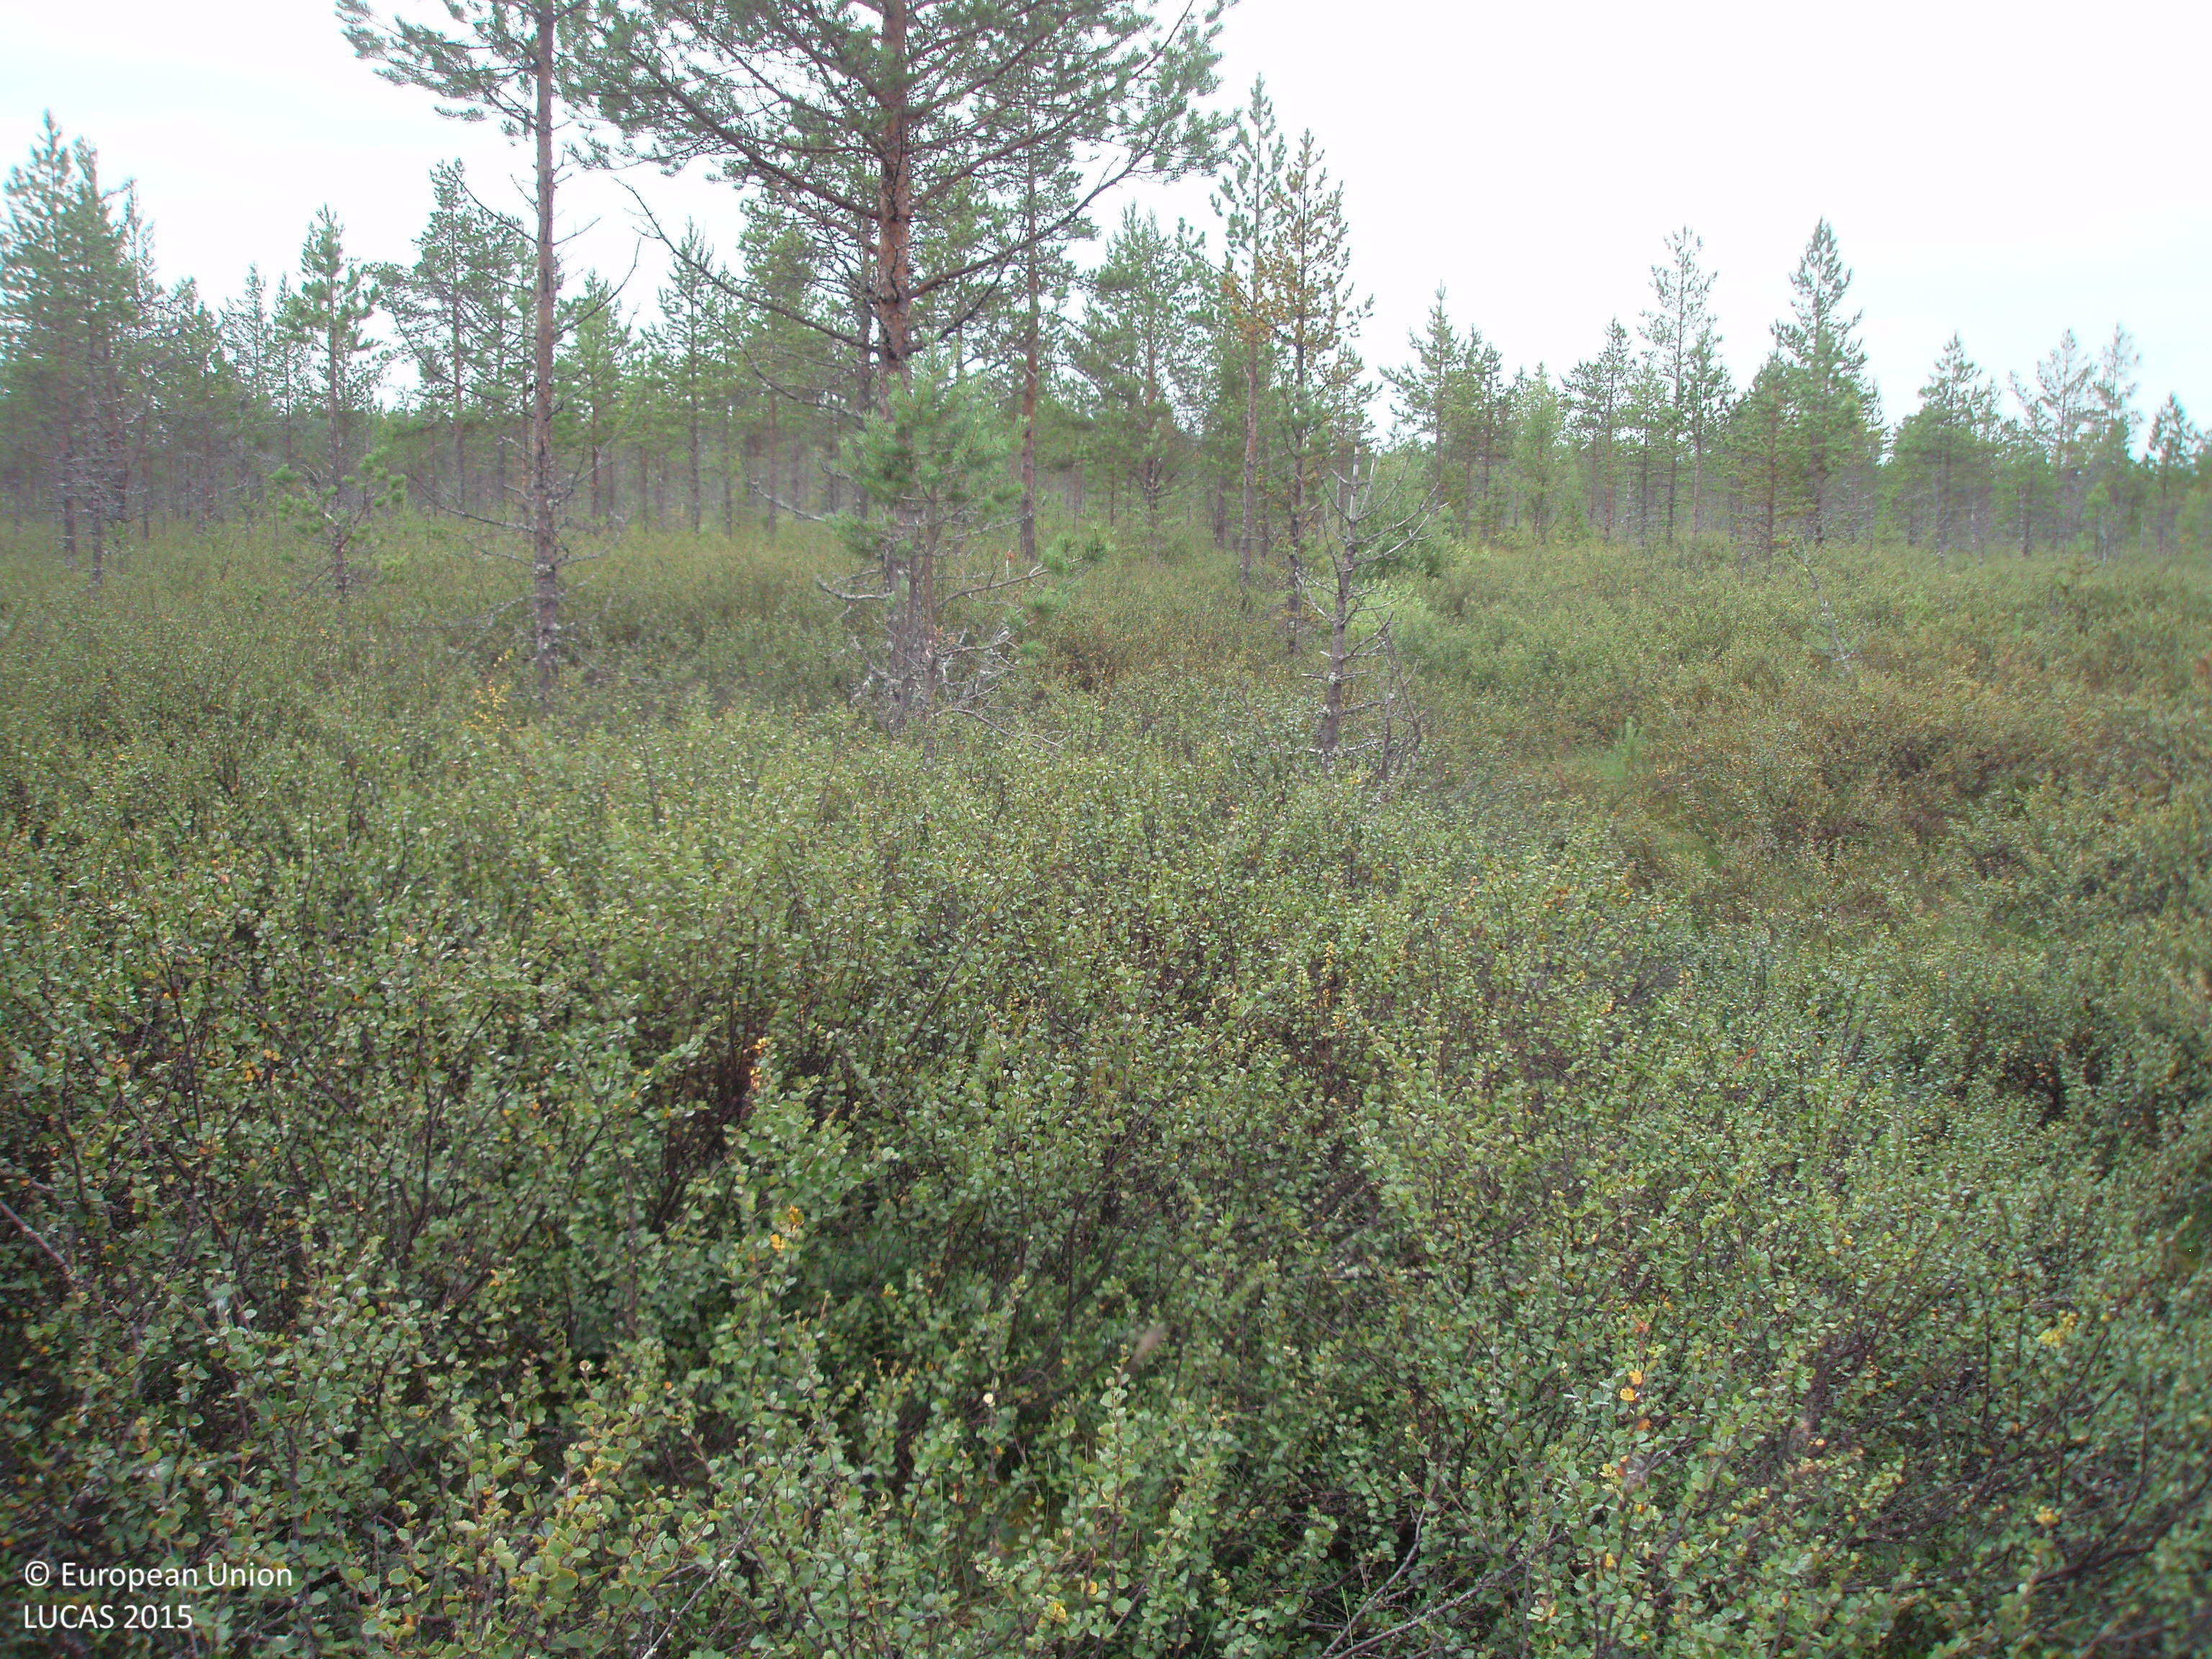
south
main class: Woodland
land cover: Pine dominated coniferous woodland
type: boreal forest
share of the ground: 10 - 25 %
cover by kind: shrubs 80 %, coniferous forest trees 20 %
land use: Forestry
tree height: > 5 m
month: August
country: FI
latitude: 65.4712
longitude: 27.0632
